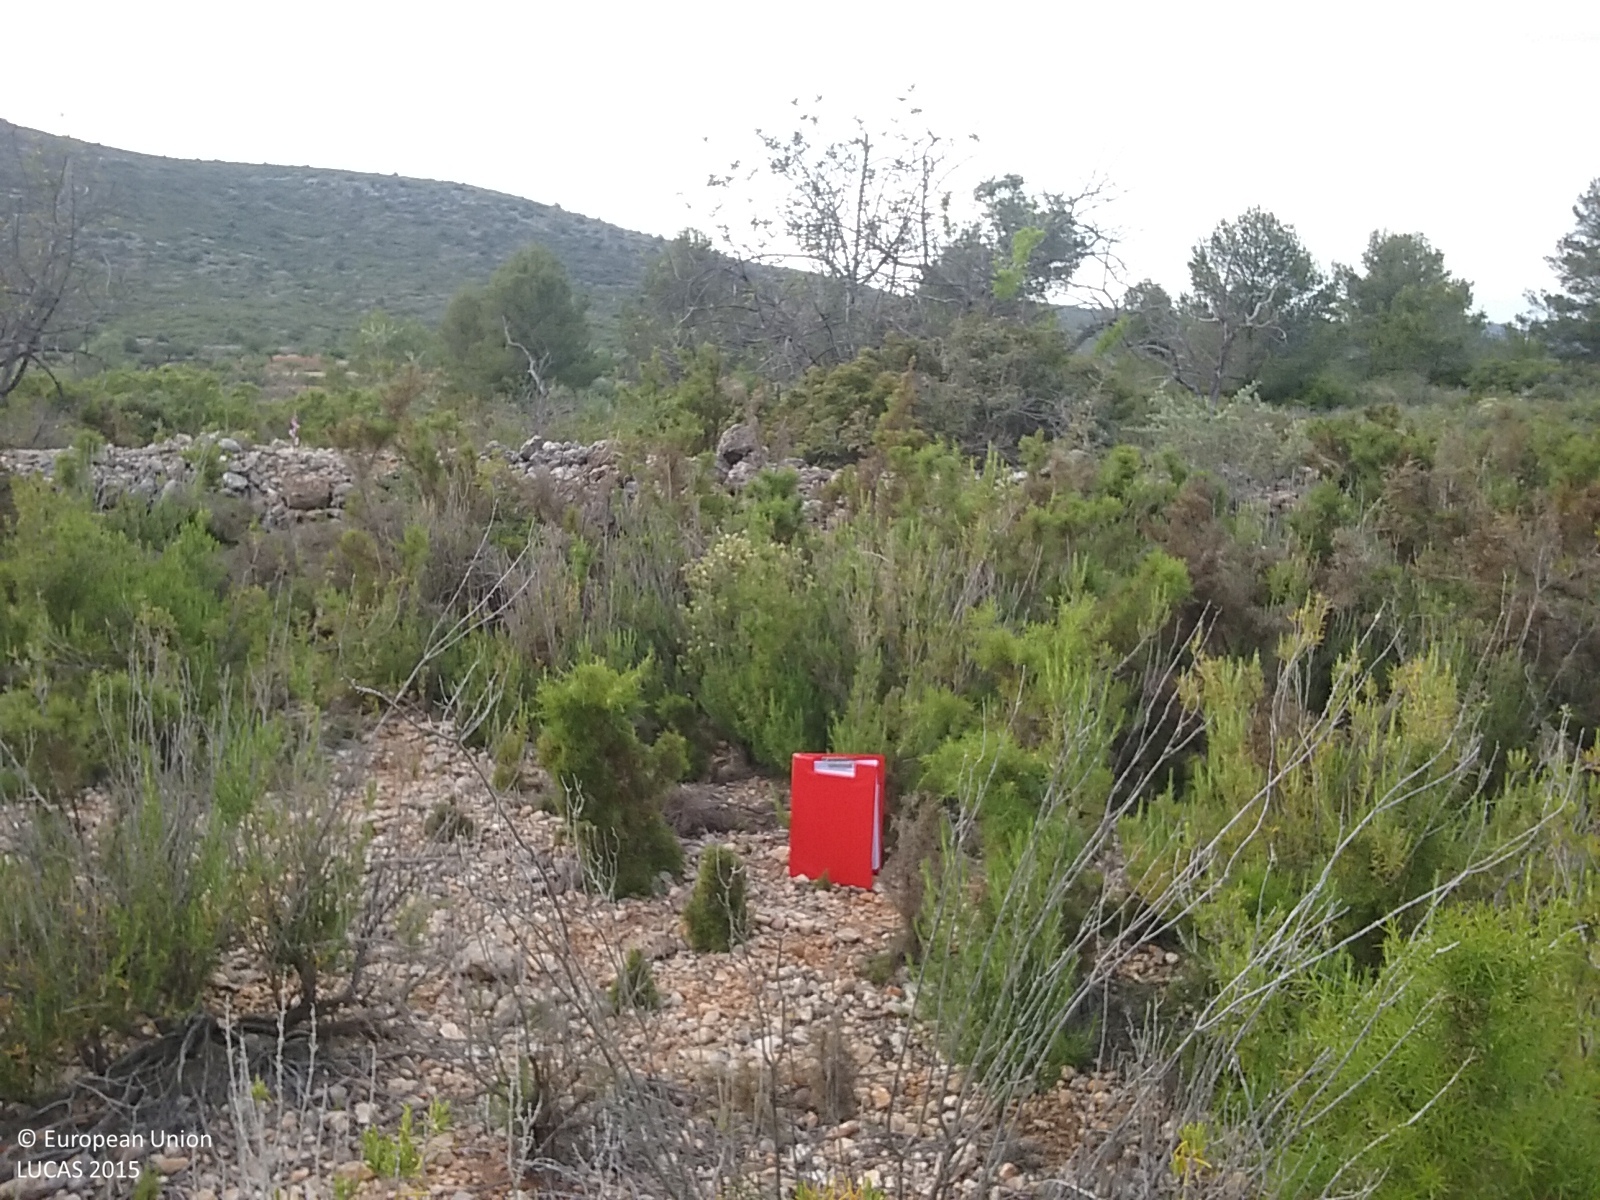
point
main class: Shrubland
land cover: Shrubland with sparse tree cover
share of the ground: 50 - 75 %
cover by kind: shrubs 70 %, unconsolidated bare surface 25 %, broadleaved forest trees 5 %
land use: Abandoned areas
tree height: < 5 m
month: May
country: ES
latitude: 40.2222
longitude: 0.1144
